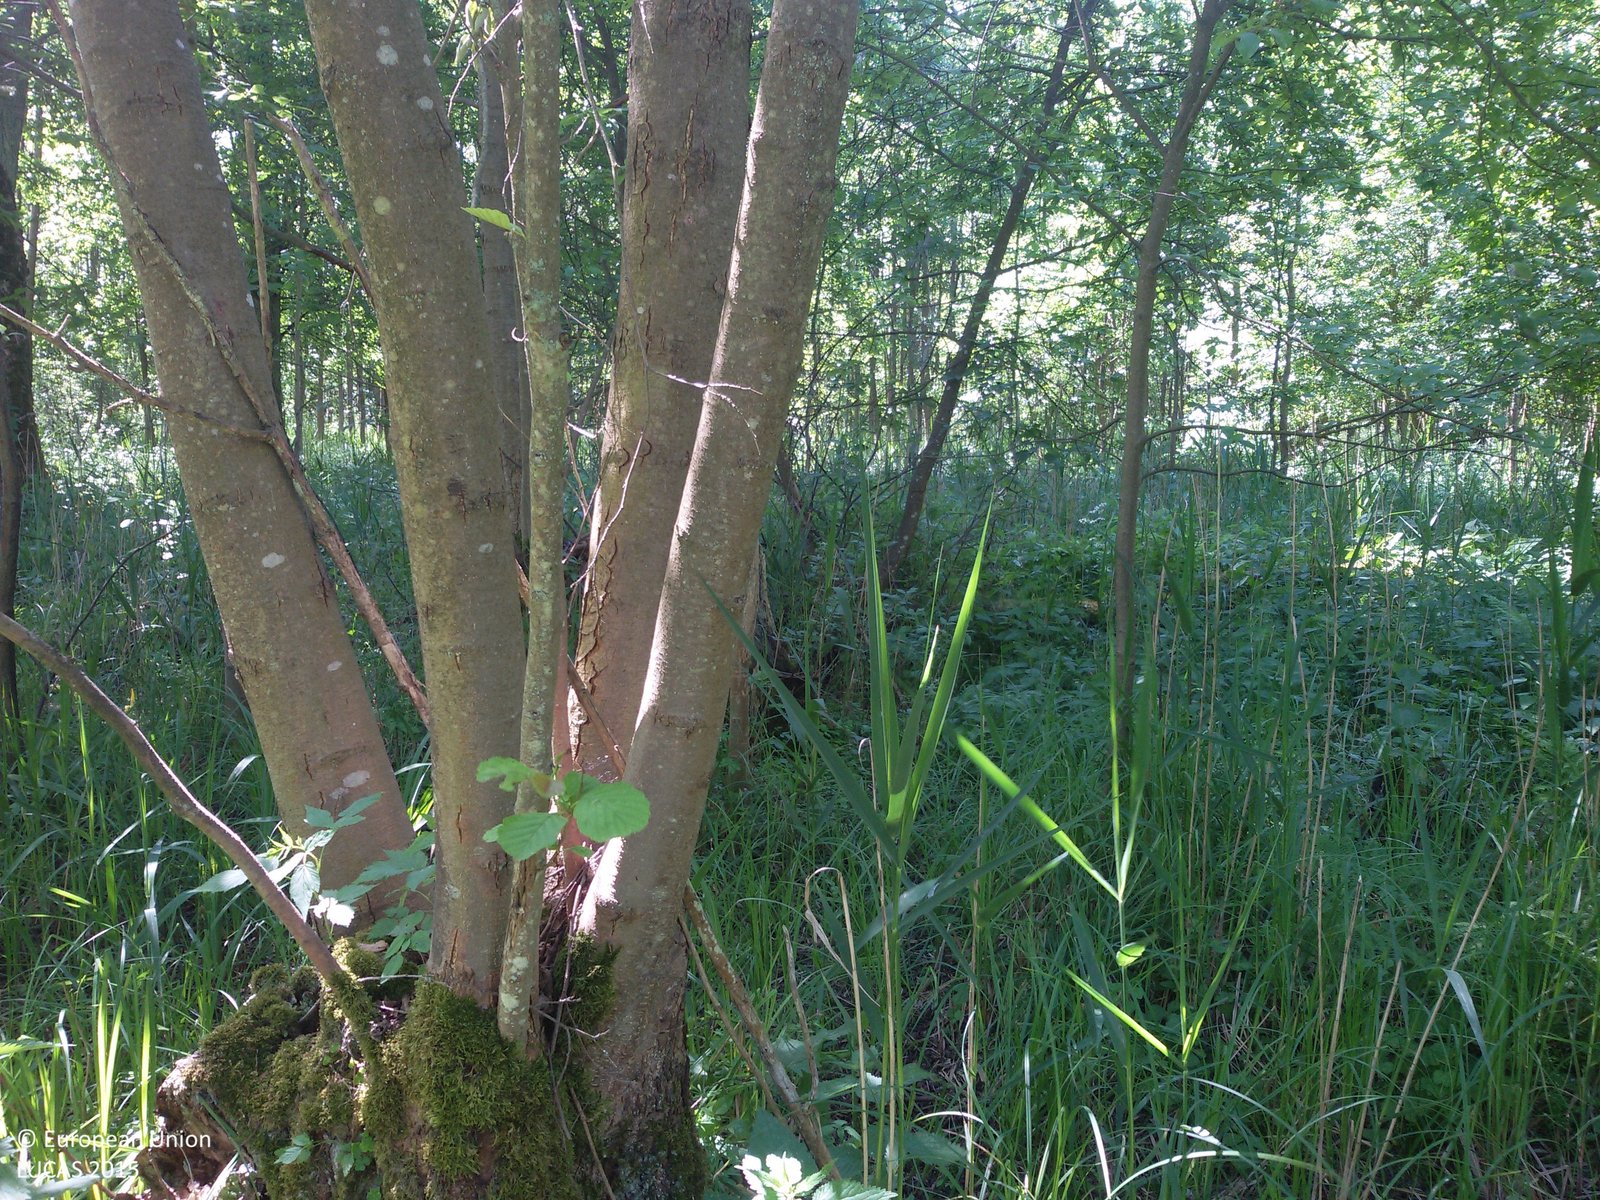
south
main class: Woodland
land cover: Broadleaved woodland
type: beech forest
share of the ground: 50 - 75 %
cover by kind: broadleaved forest trees 60 %, shrubs 20 %, herbaceous plants 20 %
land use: Forestry
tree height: > 5 m
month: June
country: PL
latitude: 53.2852
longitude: 17.0745
